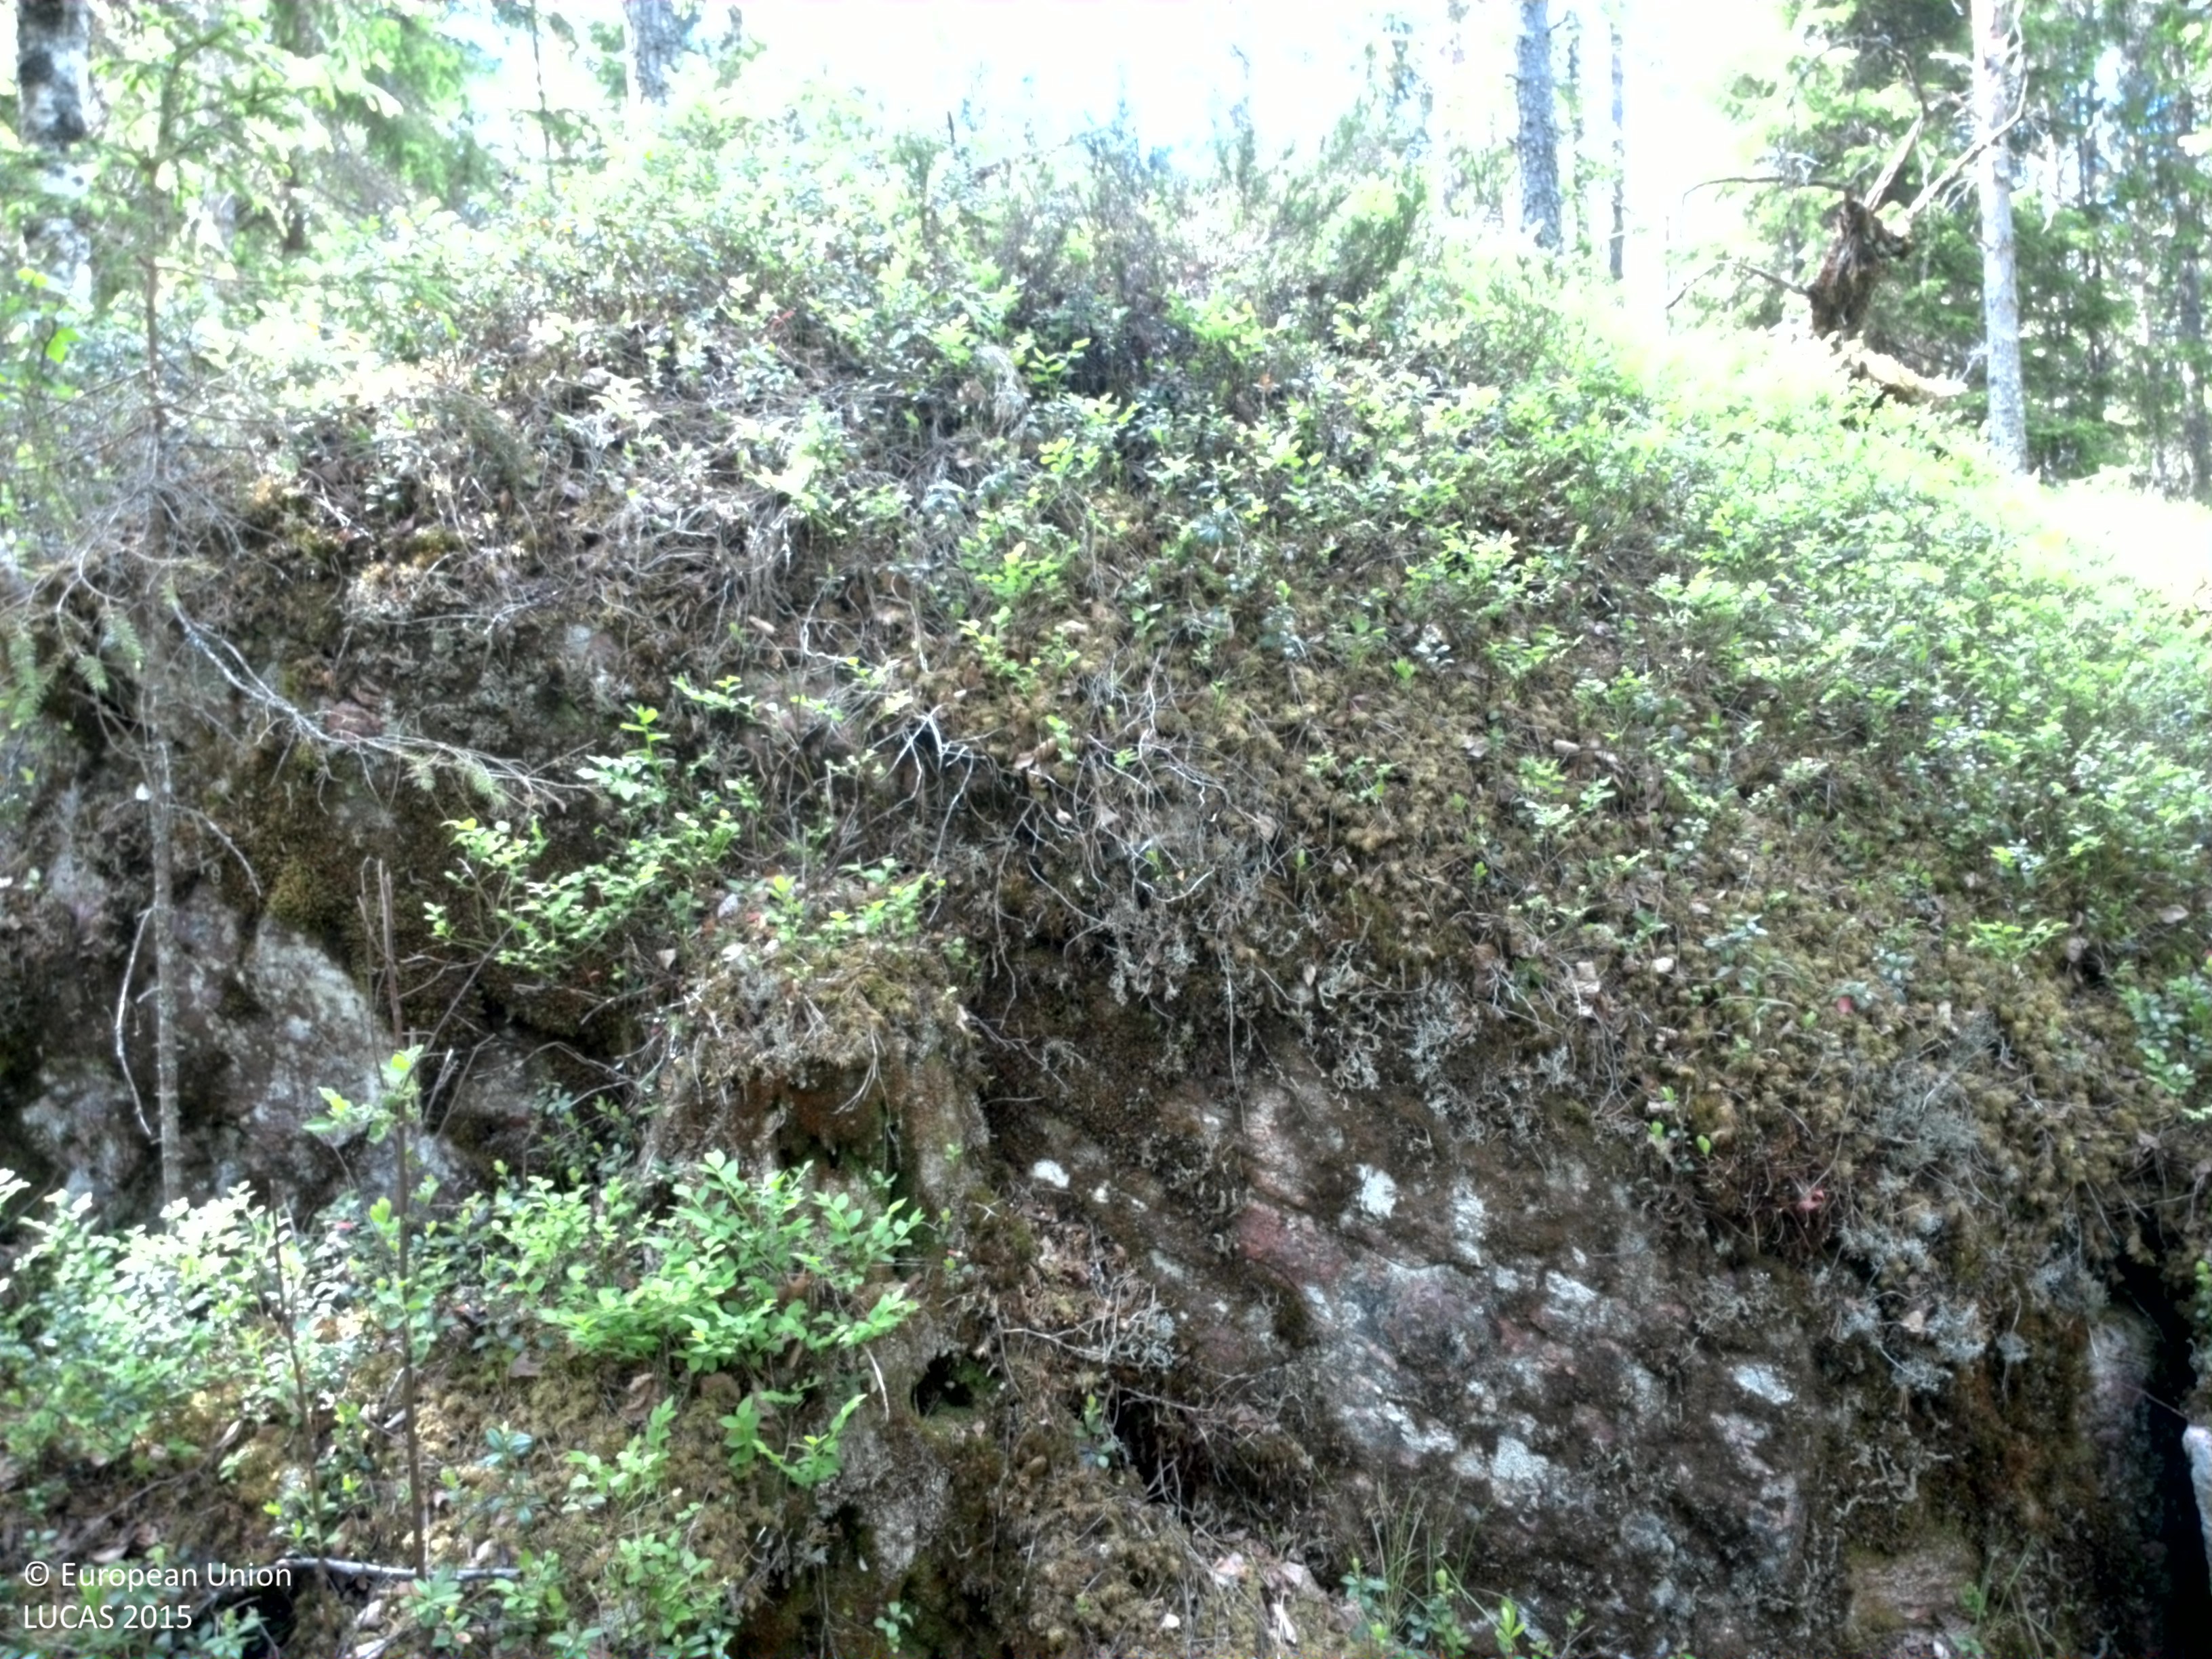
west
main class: Woodland
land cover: Pine dominated mixed woodland
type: boreal forest
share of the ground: 25 - 50 %
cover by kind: coniferous forest trees 35 %, lichens and mosses 25 %, shrubs 20 %, broadleaved forest trees 15 %, herbaceous plants 5 %
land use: Forestry
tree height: > 5 m
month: June
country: SE
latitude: 59.6258
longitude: 12.0335
